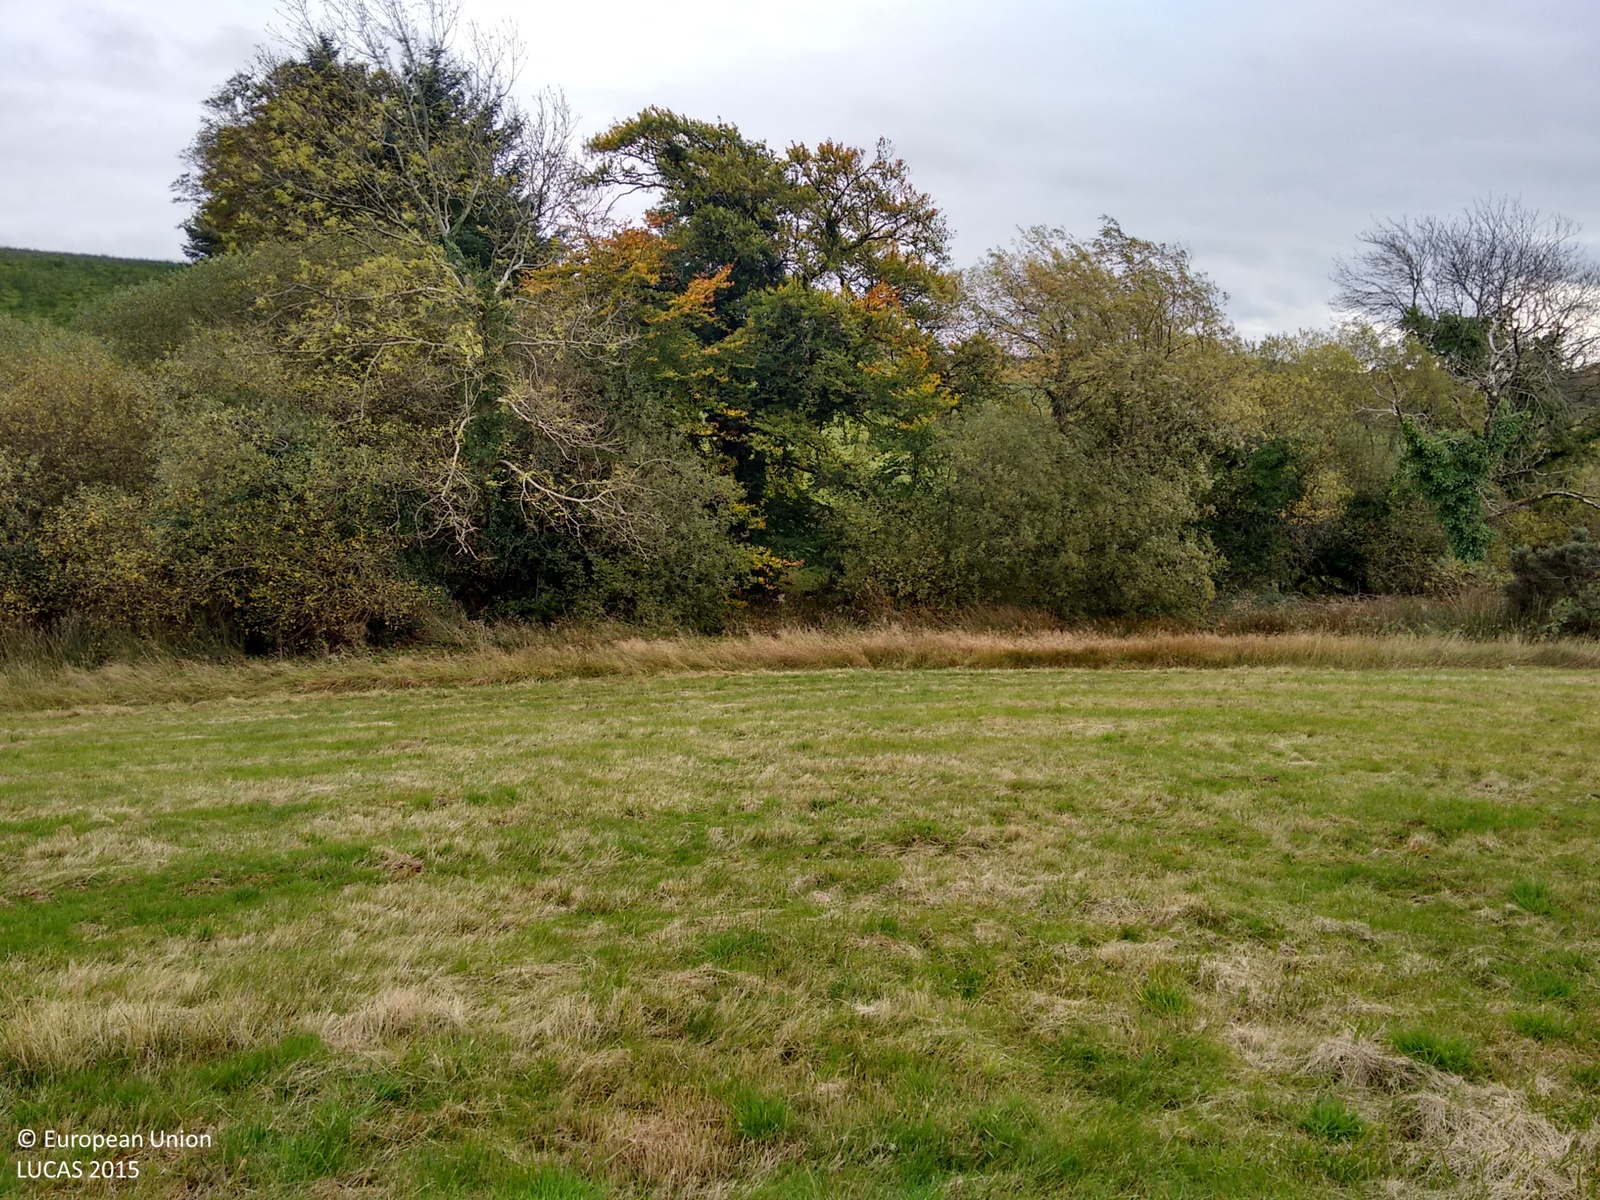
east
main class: Grassland
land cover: Grassland without tree/shrub cover
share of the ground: > 75 %
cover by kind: herbaceous plants 100 %
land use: Agriculture (excluding fallow land and kitchen gardens)
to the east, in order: Grassland without tree/shrub cover; Ditches and canals; Fences; Abandoned hedges; Grassland without tree/shrub cover
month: October
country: GB
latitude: 54.2660
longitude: -7.3952
